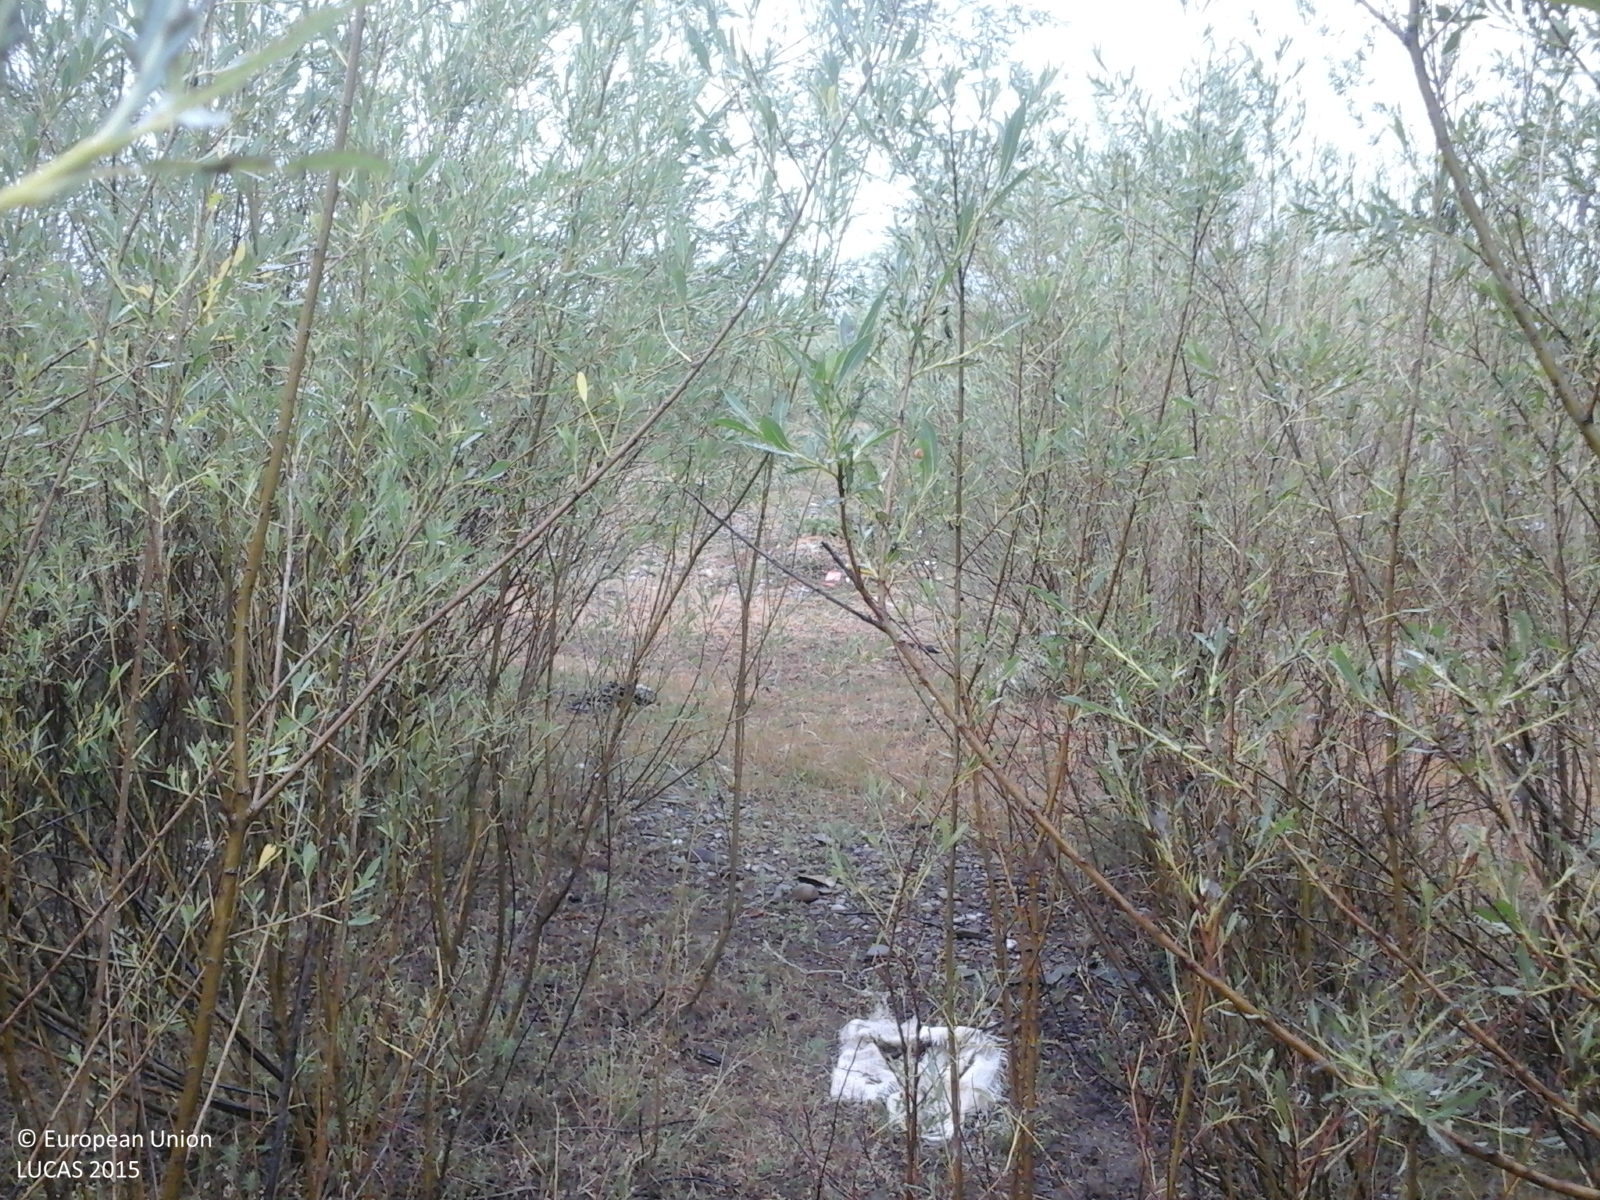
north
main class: Shrubland
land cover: Shrubland without tree cover
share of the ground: 50 - 75 %
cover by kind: shrubs 75 %, herbaceous plants 25 %
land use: Semi-natural and natural areas not in use
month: June
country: RO
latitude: 47.3542
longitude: 26.3815
